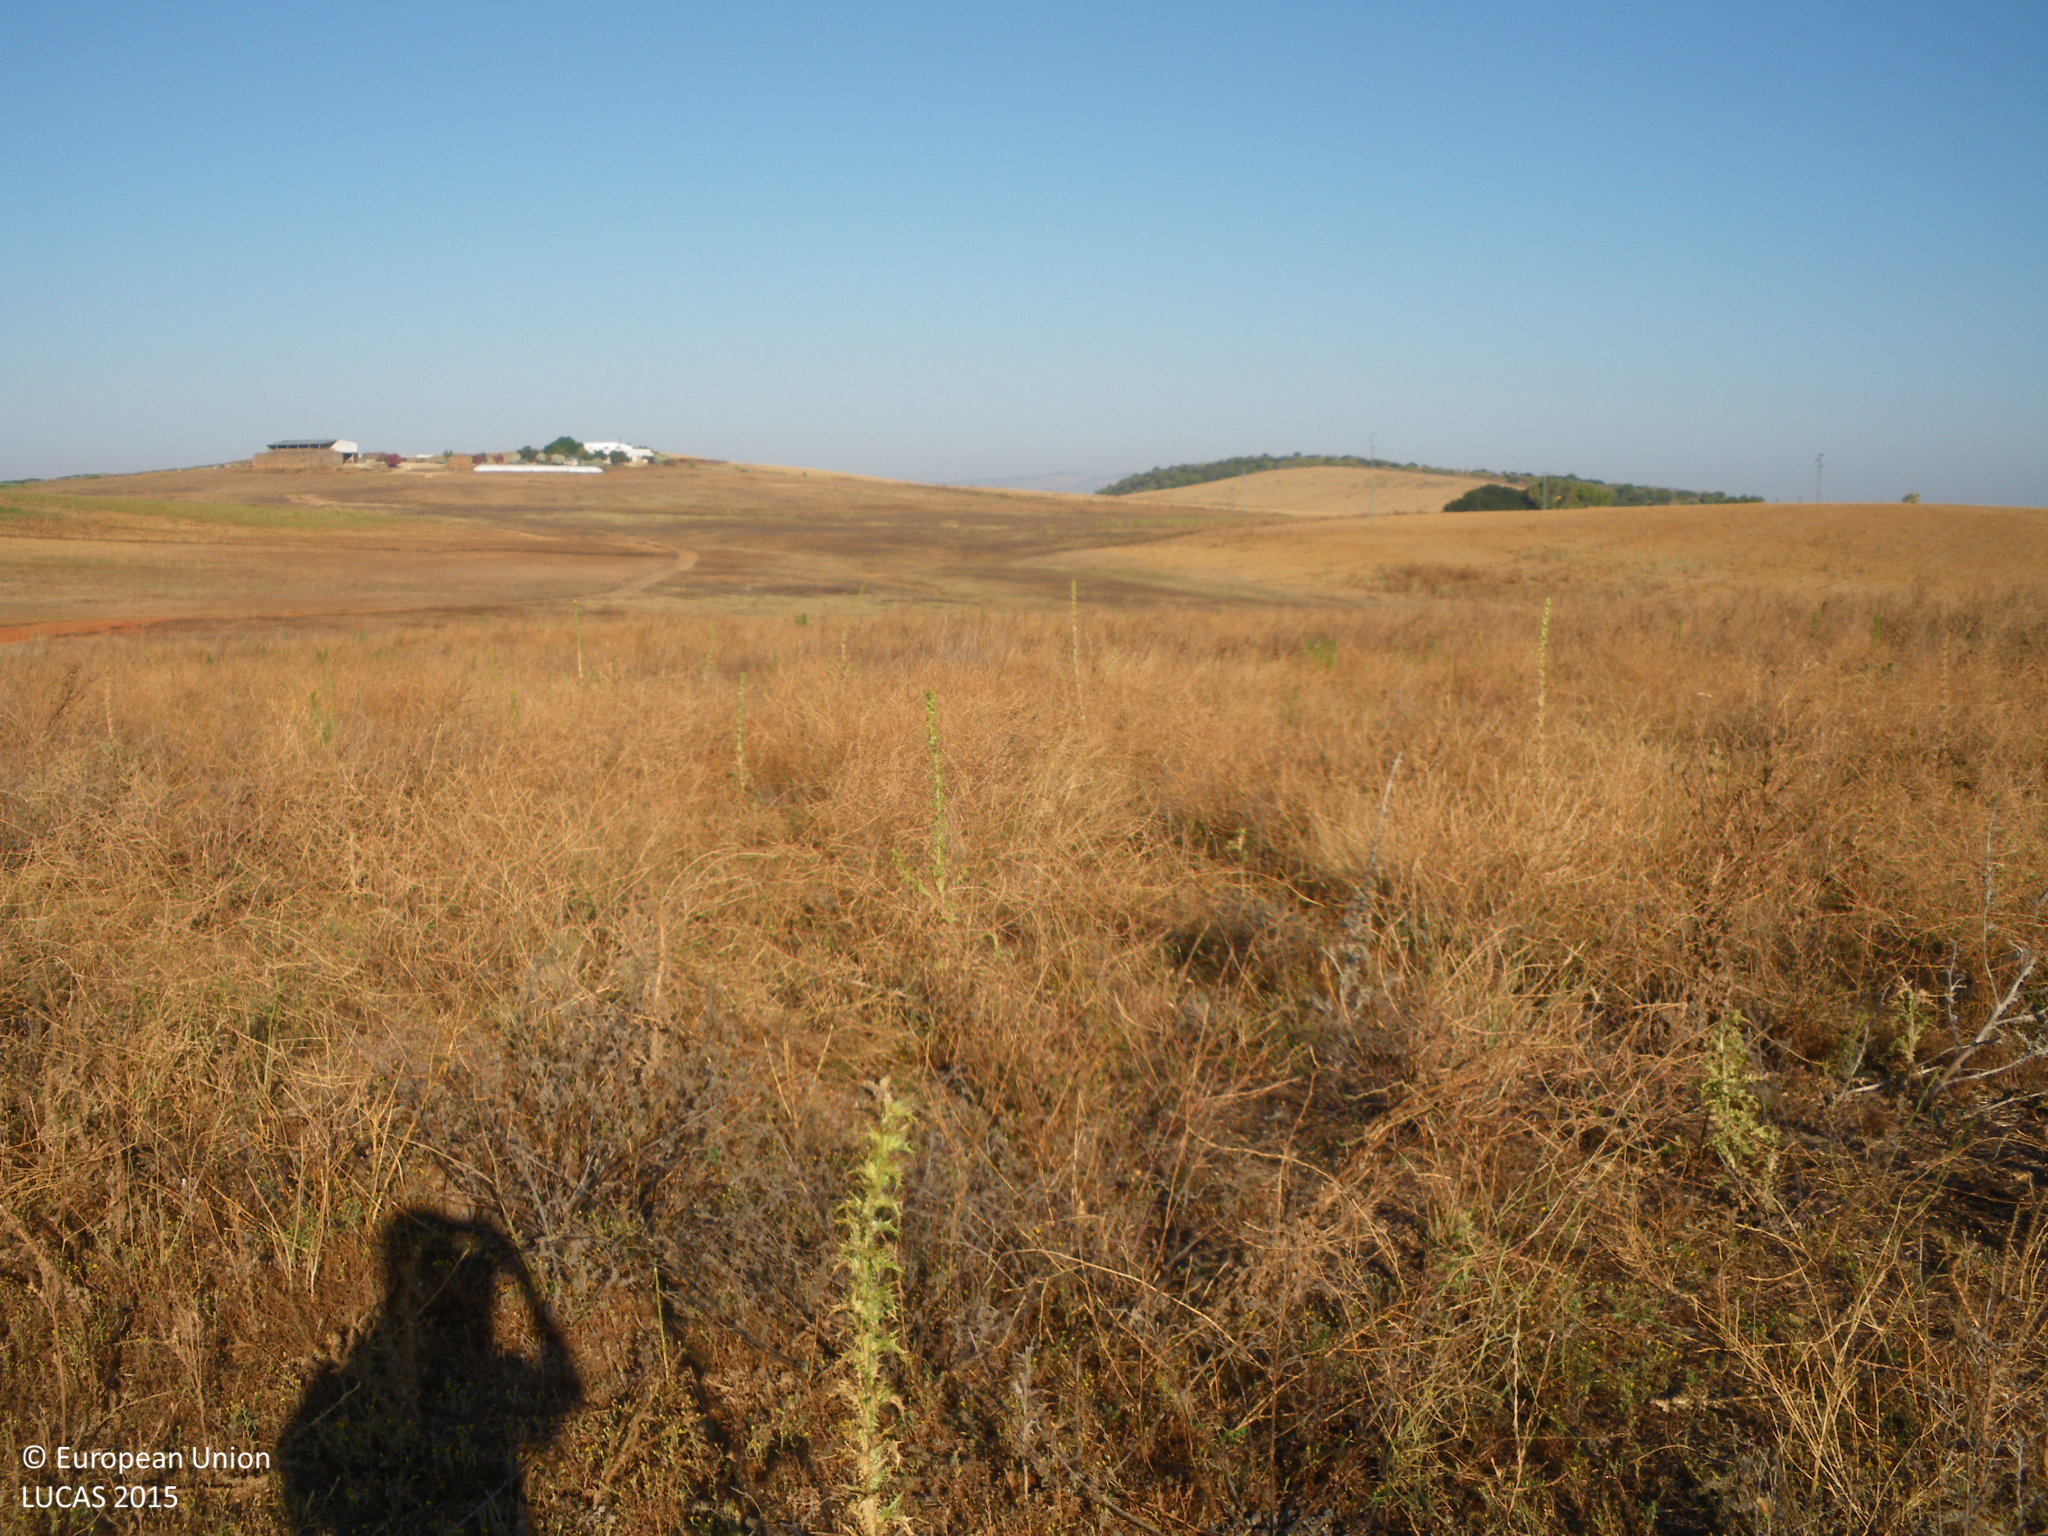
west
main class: Grassland
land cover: Grassland without tree/shrub cover
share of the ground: > 75 %
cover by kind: herbaceous plants 95 %, unconsolidated bare surface 5 %
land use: Agriculture (excluding fallow land and kitchen gardens)
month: June
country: ES
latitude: 36.8296
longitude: -5.7622
